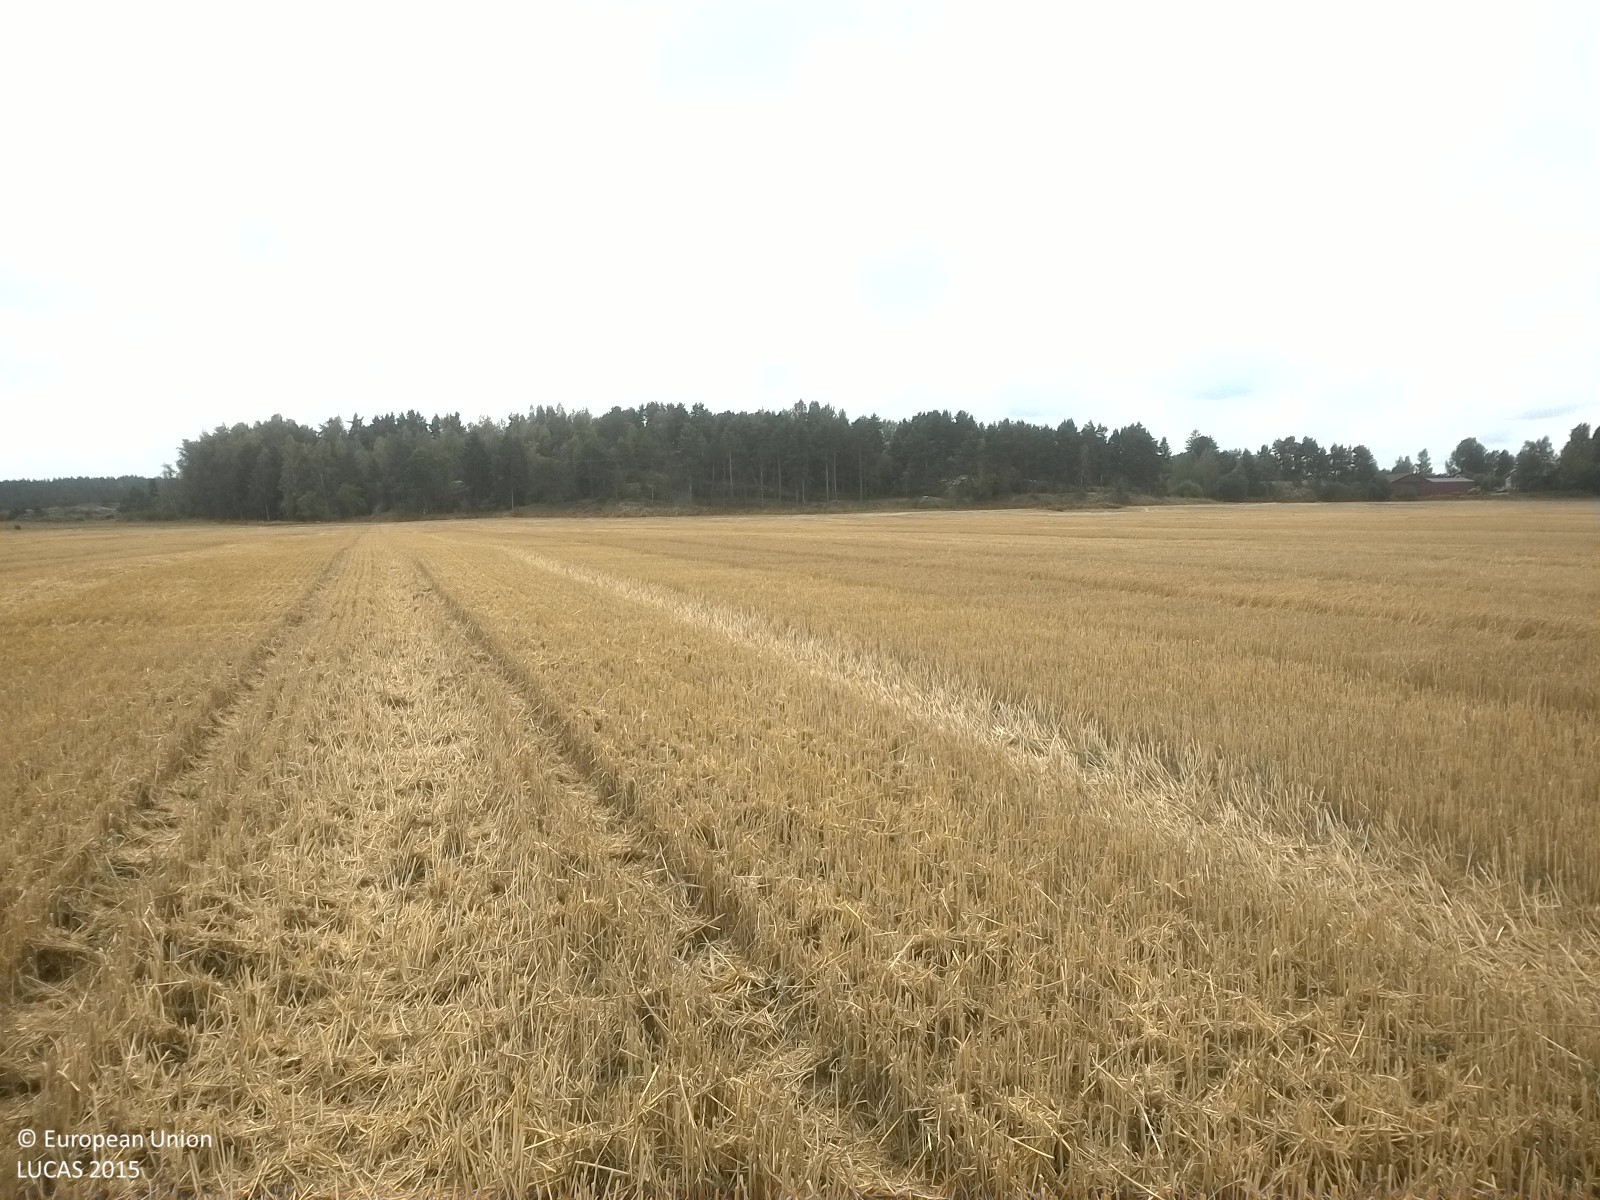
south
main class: Cropland
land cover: Common wheat
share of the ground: > 75 %
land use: Agriculture (excluding fallow land and kitchen gardens)
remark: Harvested field
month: September
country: SE
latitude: 58.5721
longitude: 16.4092
